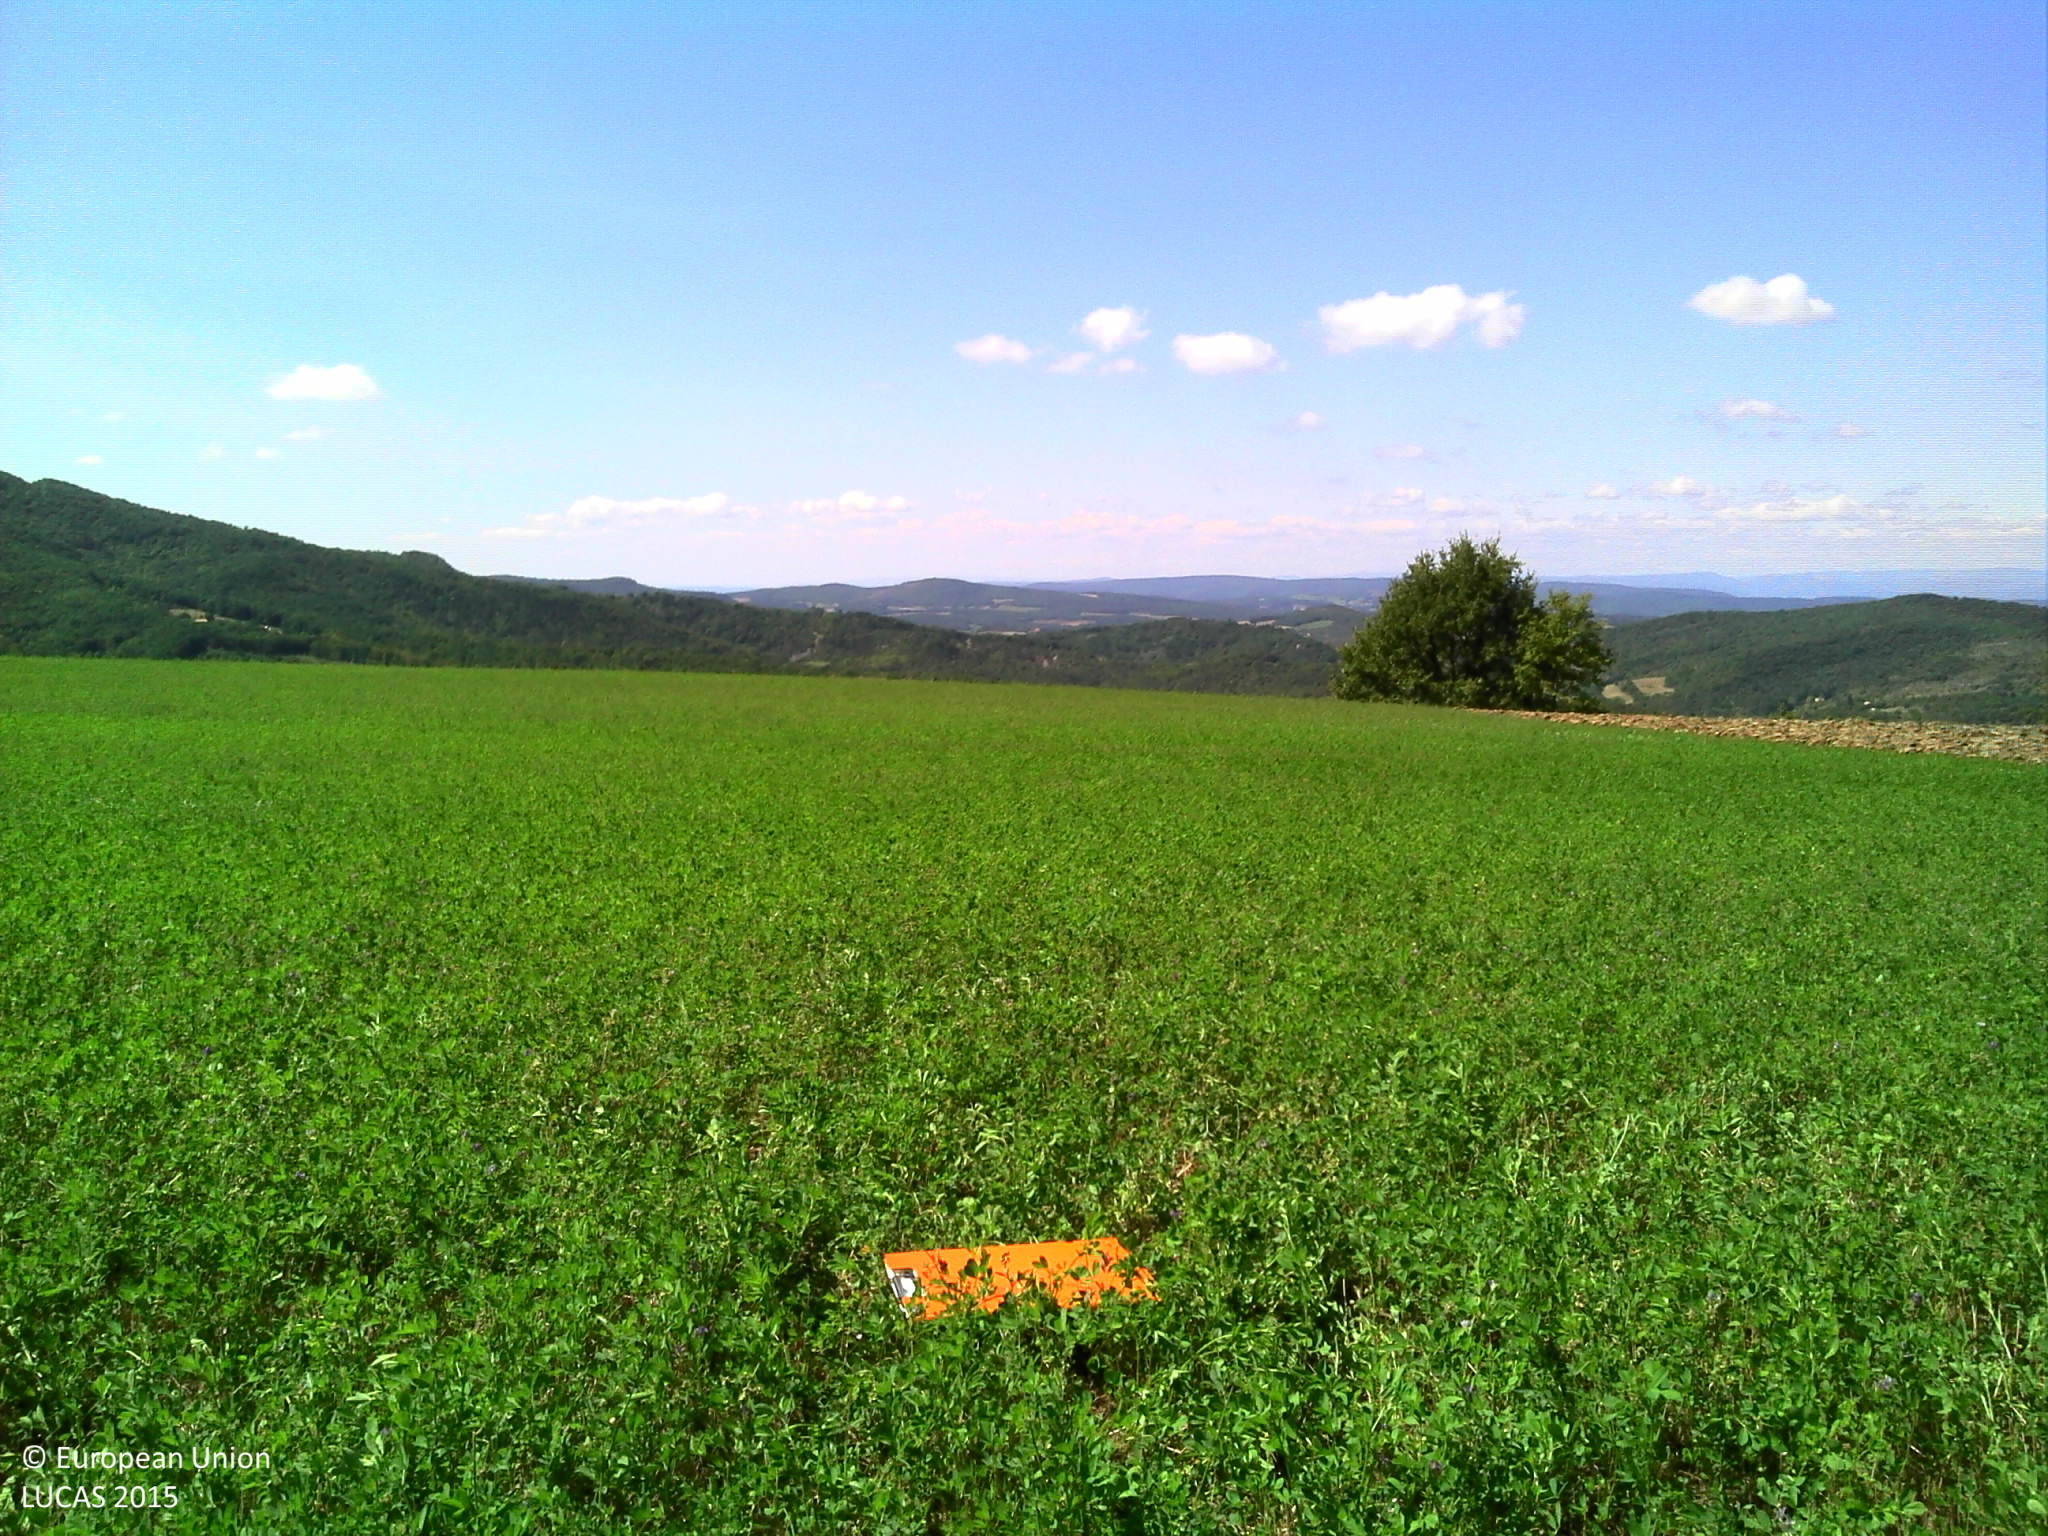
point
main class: Cropland
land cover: Lucerne
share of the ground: > 75 %
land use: Agriculture (excluding fallow land and kitchen gardens)
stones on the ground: 25 - 50 %
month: September
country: FR
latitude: 44.6852
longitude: 5.0733
